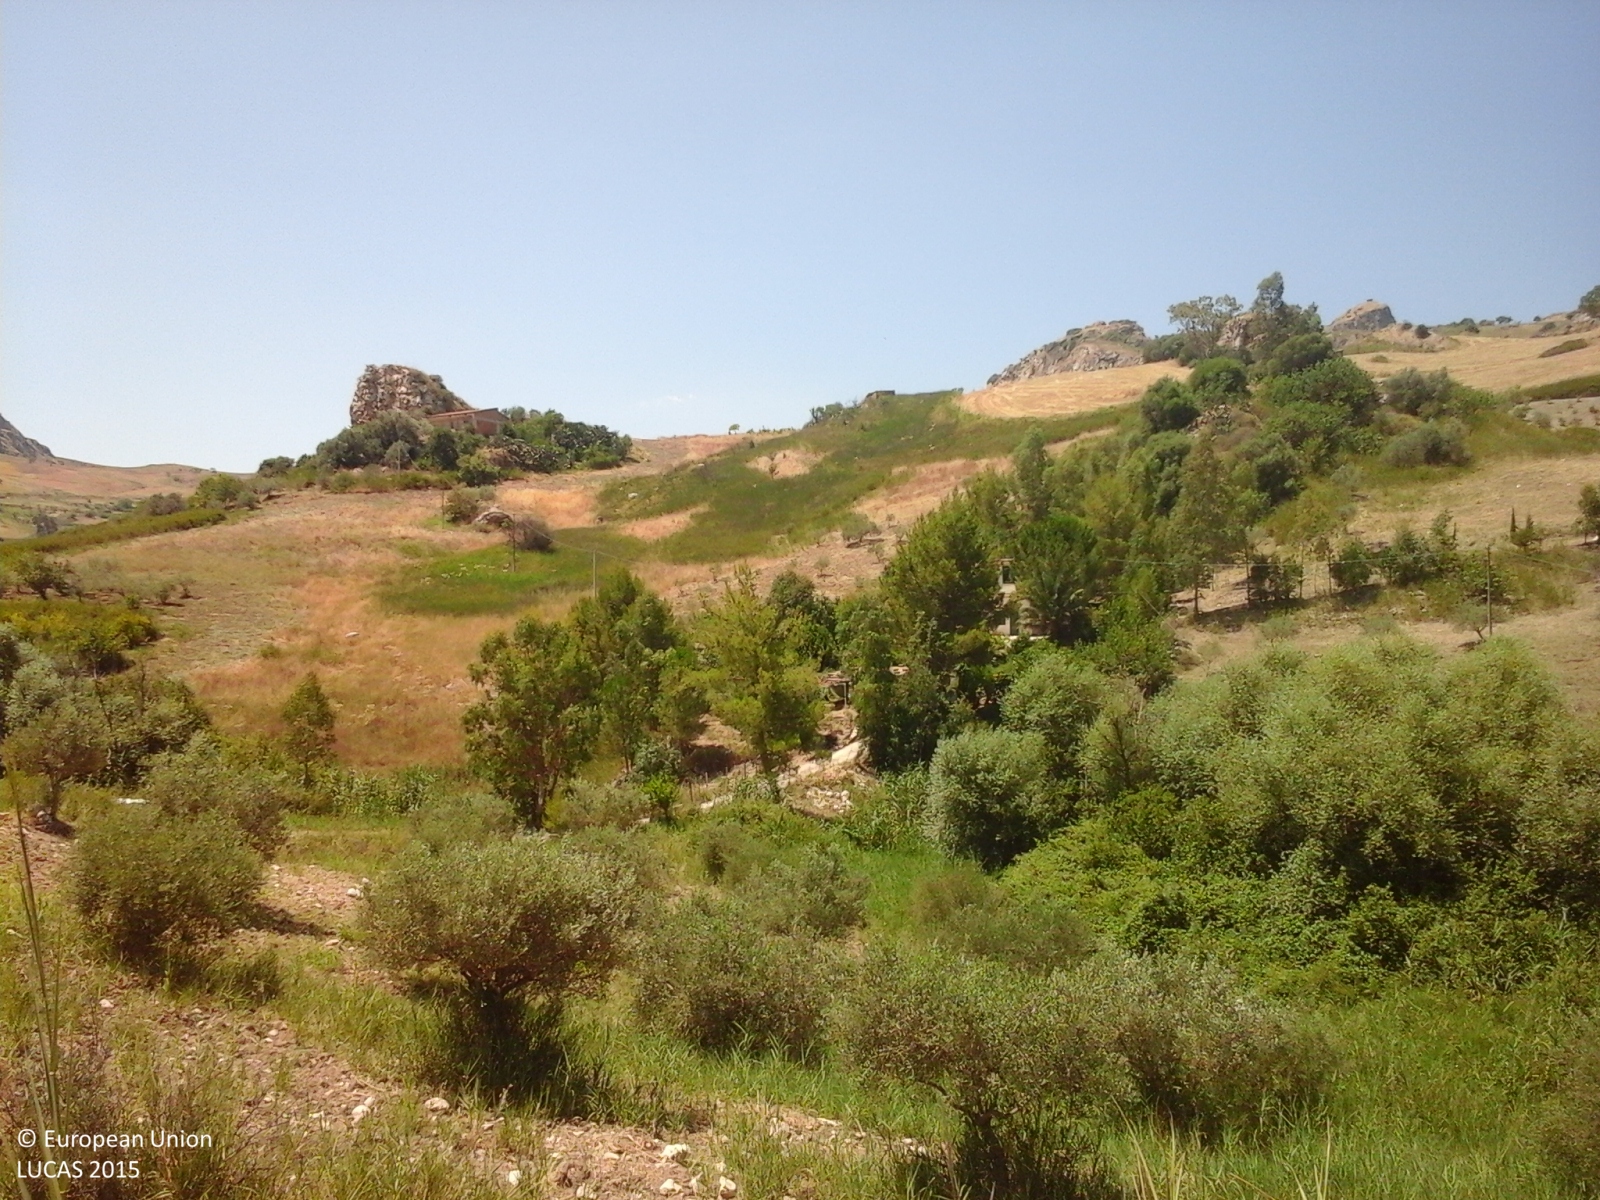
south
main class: Shrubland
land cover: Shrubland without tree cover
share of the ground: > 75 %
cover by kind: herbaceous plants 90 %, shrubs 10 %
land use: Abandoned areas
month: July
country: IT
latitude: 37.4819
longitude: 13.5353
